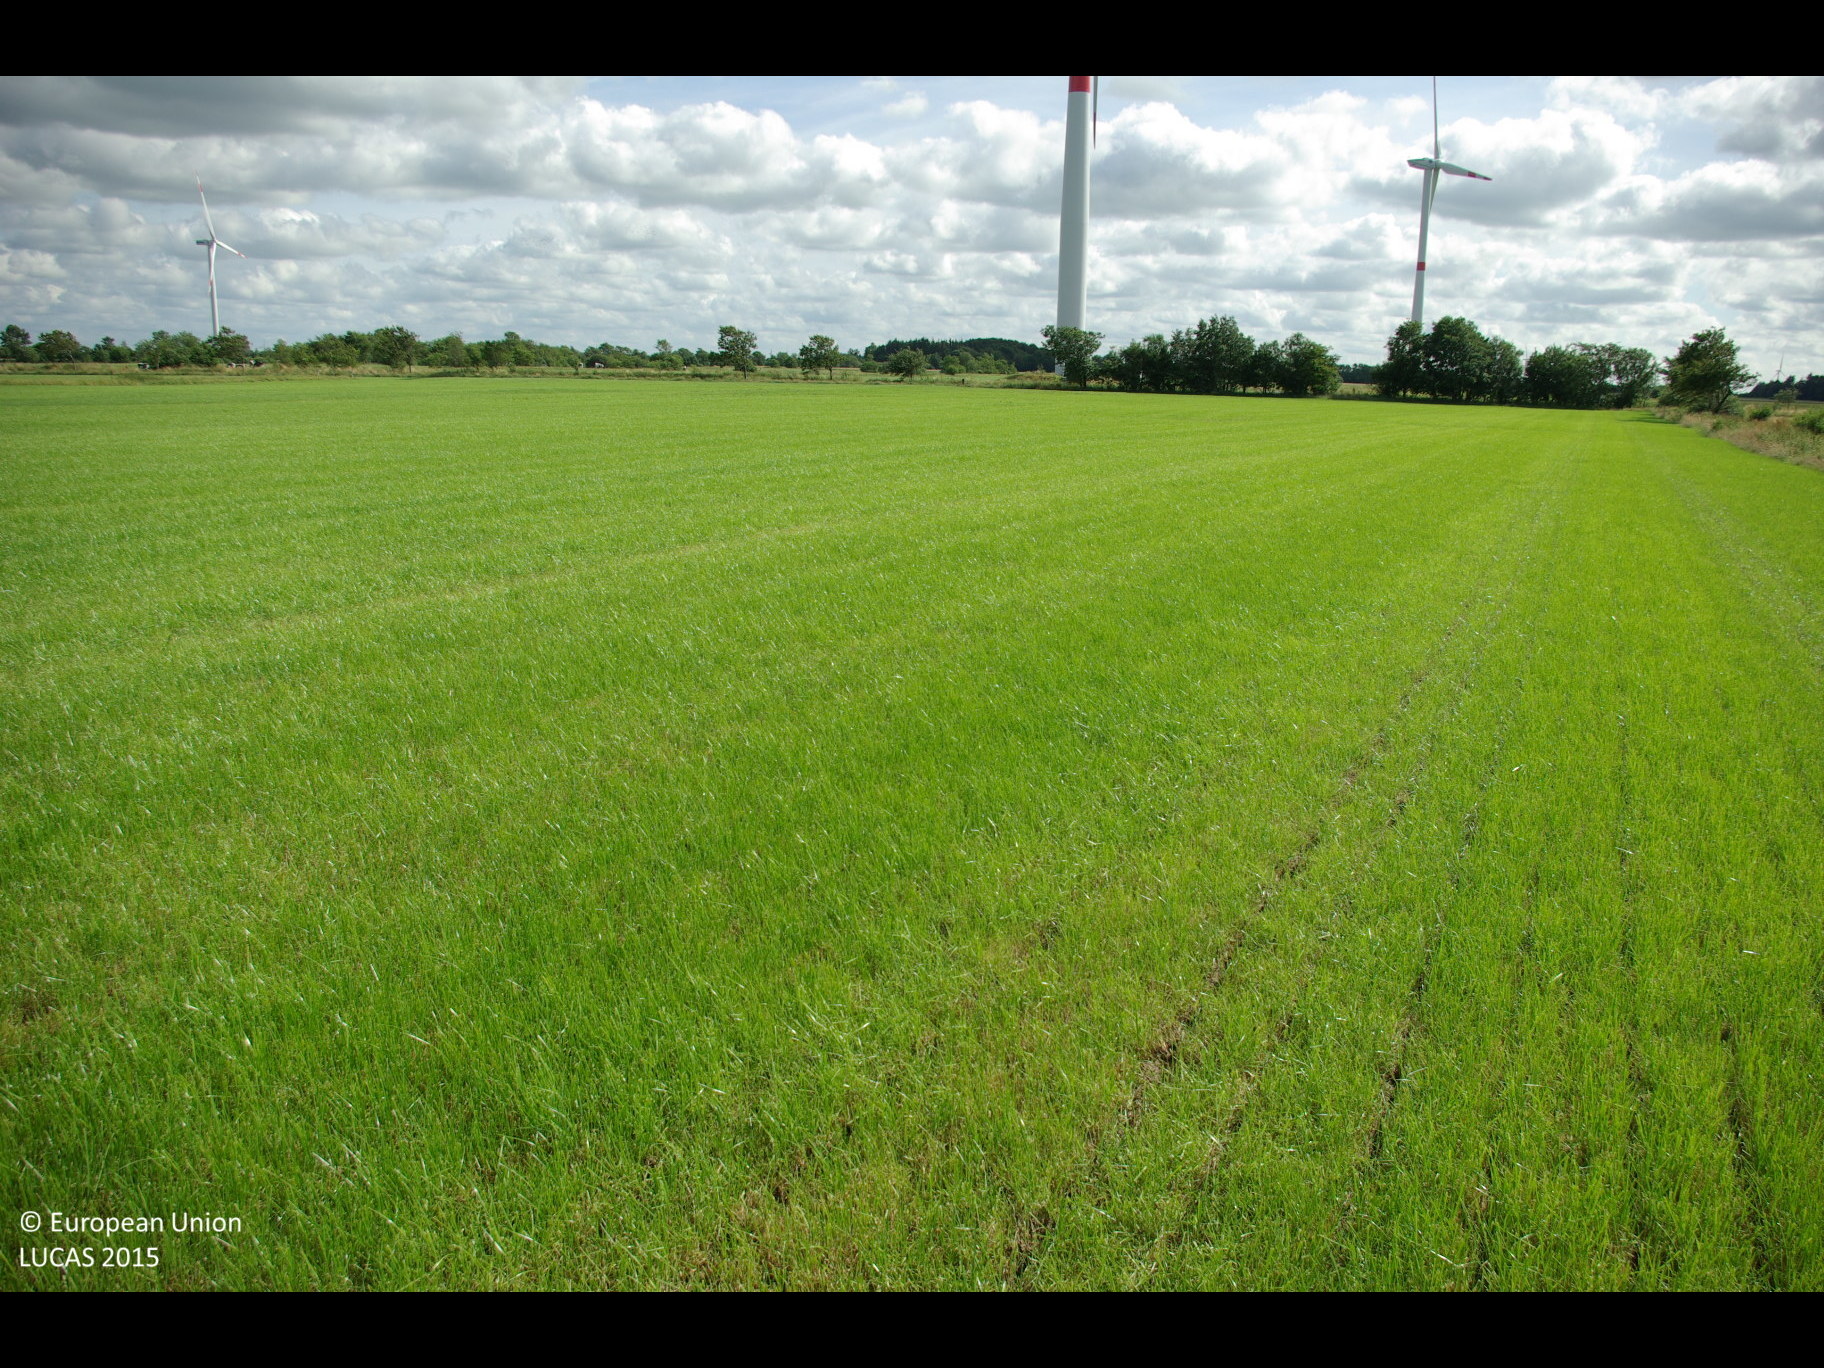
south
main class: Grassland
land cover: Grassland without tree/shrub cover
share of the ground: > 75 %
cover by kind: herbaceous plants 100 %
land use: Agriculture (excluding fallow land and kitchen gardens)
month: July
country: DE
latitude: 54.8010
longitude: 9.1761
